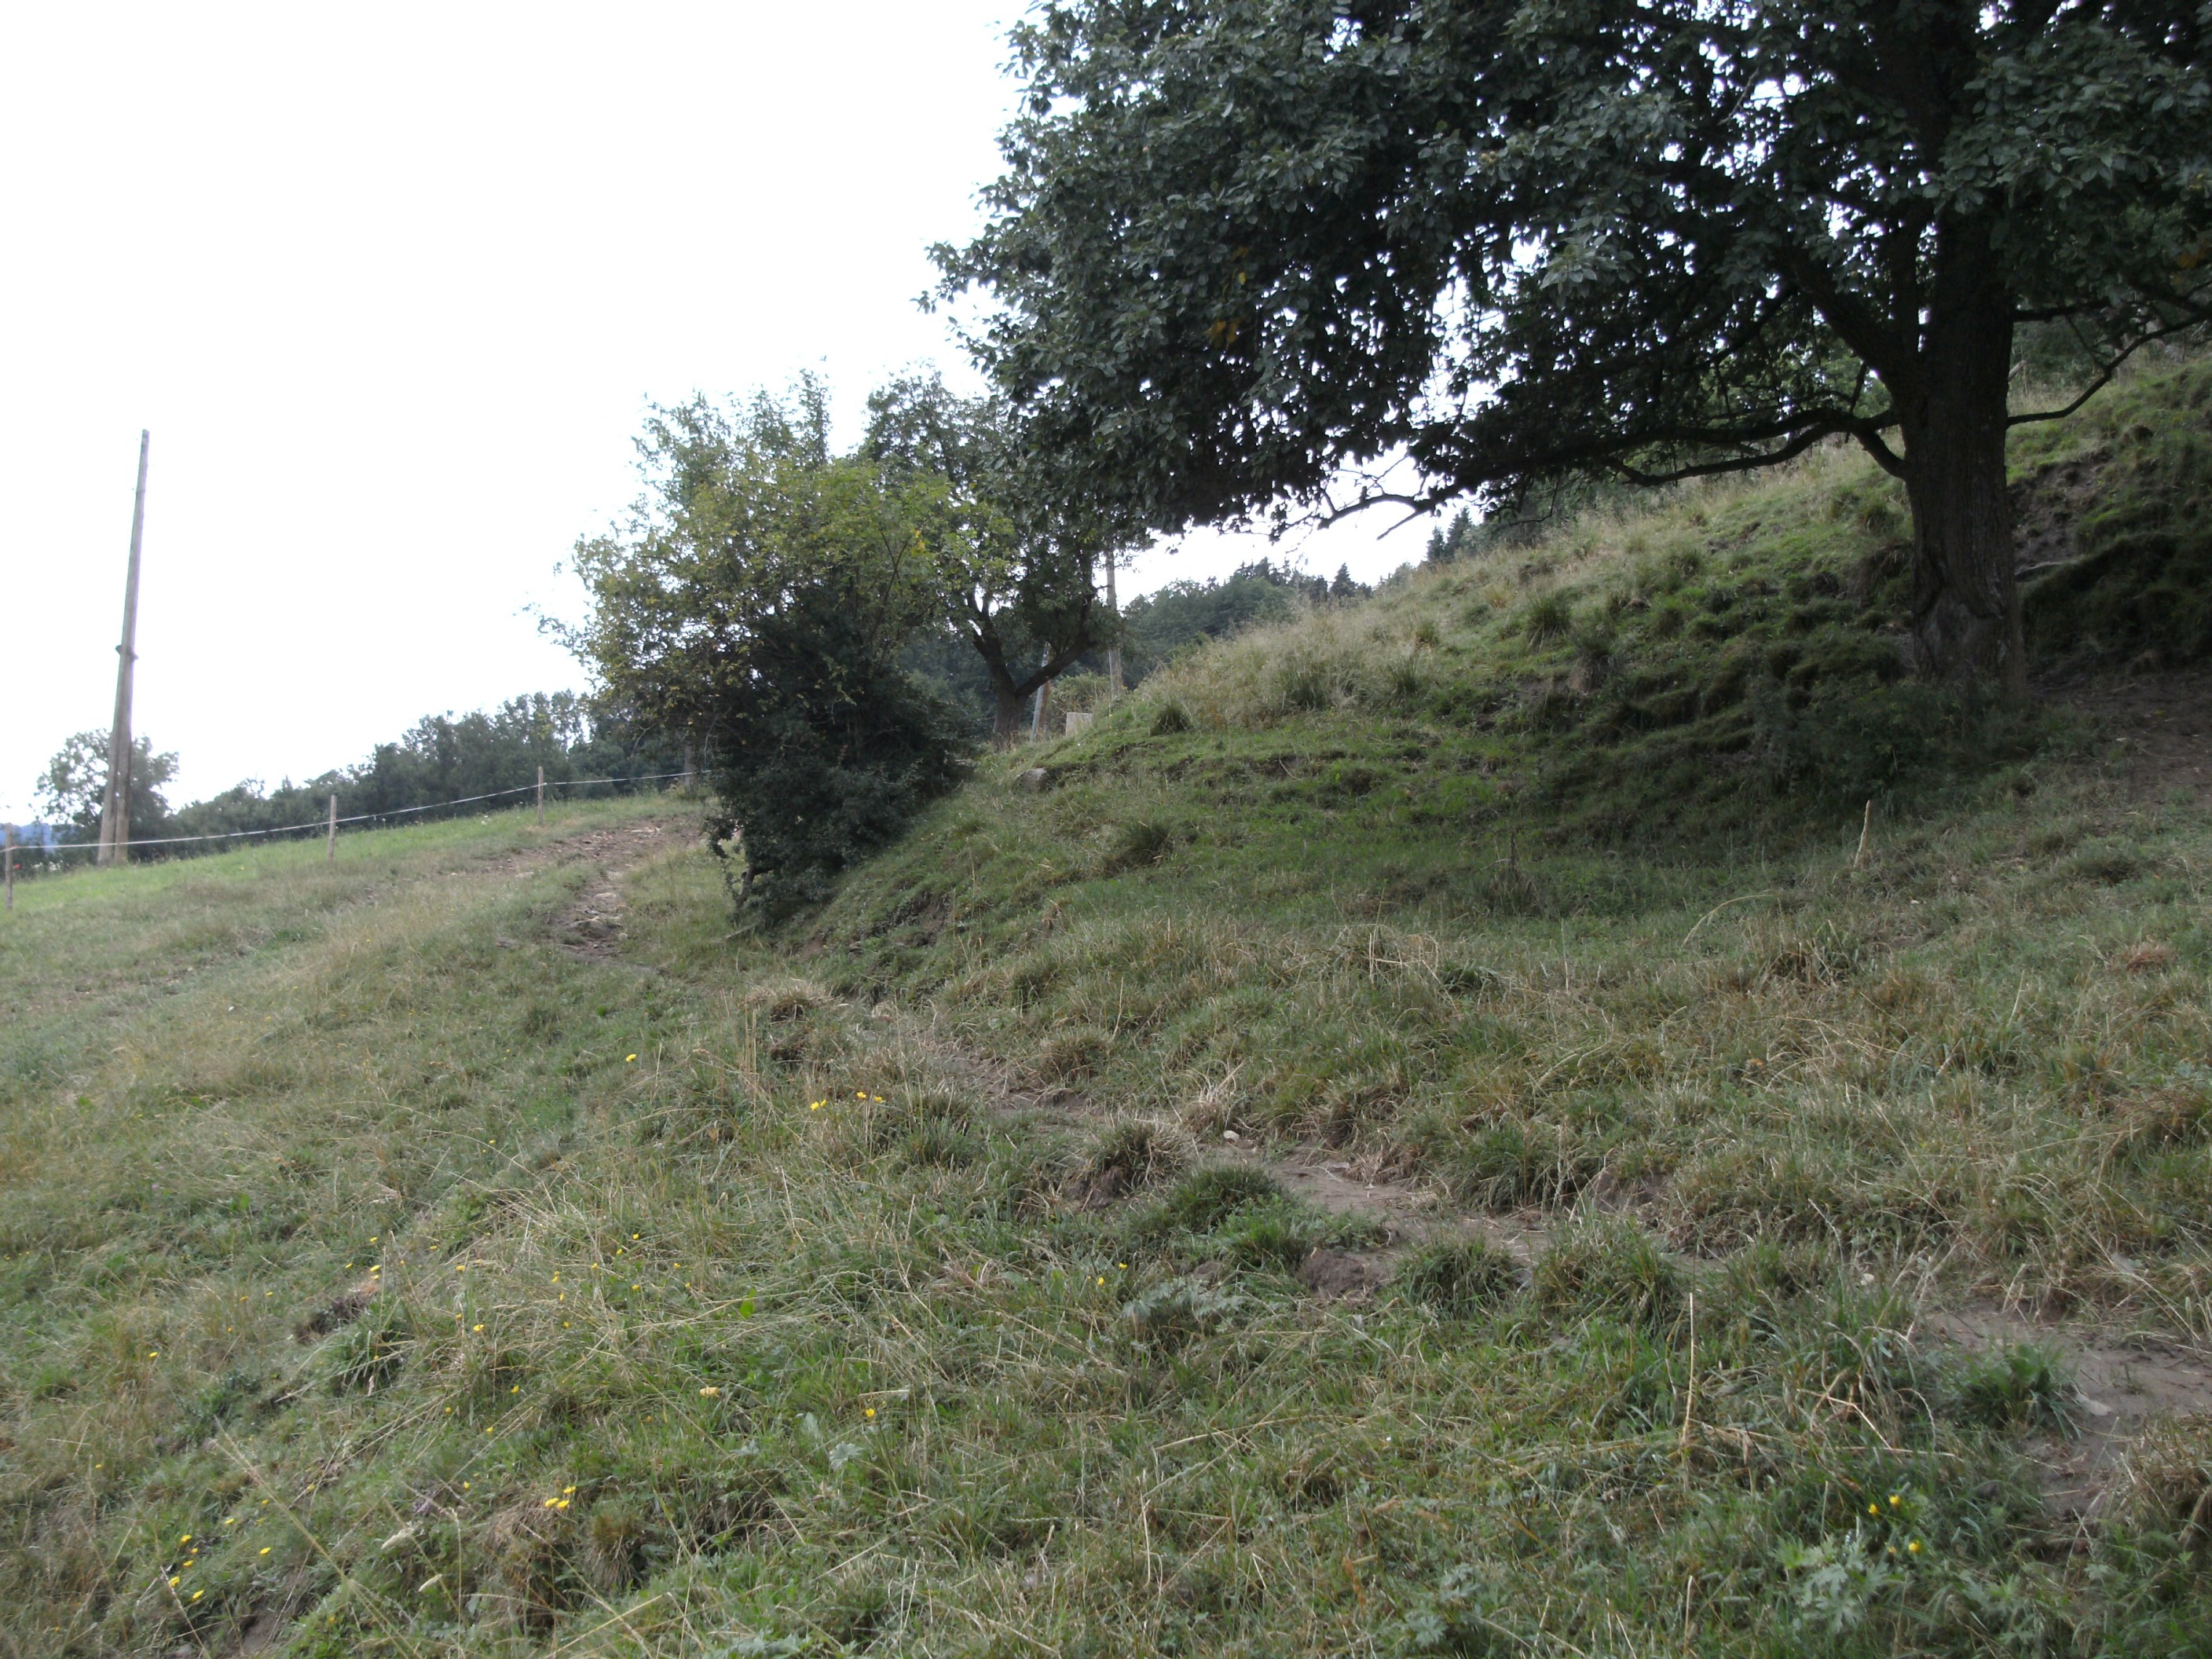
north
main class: Cropland
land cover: Pear fruit
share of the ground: > 75 %
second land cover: Grassland without tree/shrub cover
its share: > 75 %
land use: Agriculture (excluding fallow land and kitchen gardens)
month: July
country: AT
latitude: 46.8731
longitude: 14.8398
